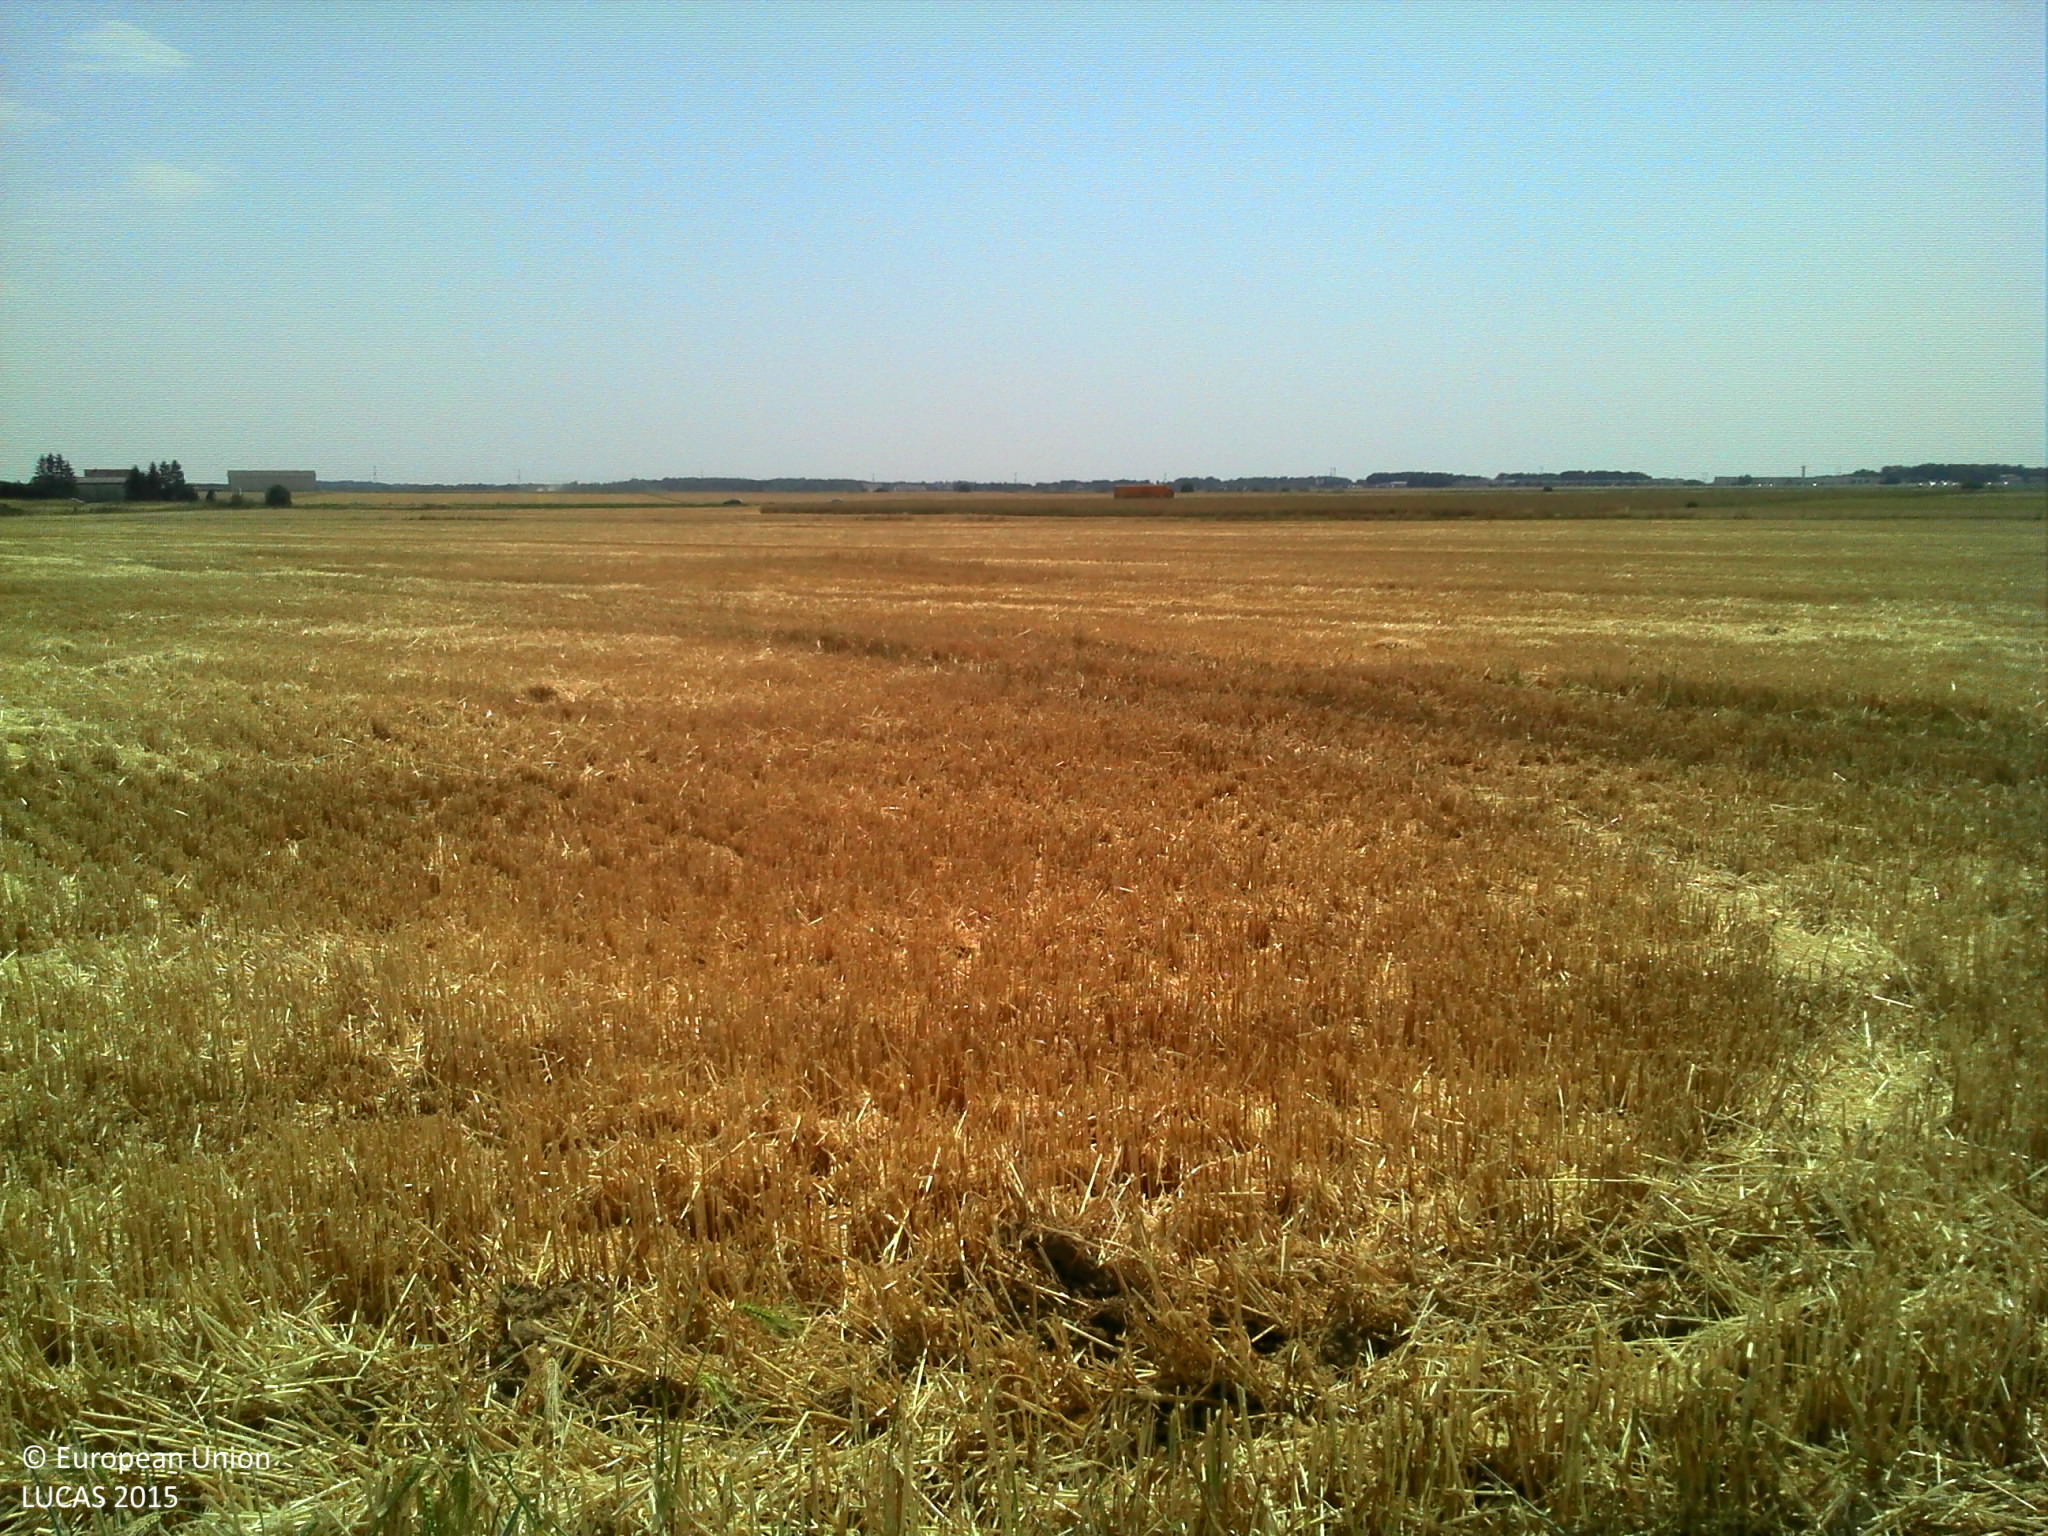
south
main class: Cropland
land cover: Barley
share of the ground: > 75 %
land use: Agriculture (excluding fallow land and kitchen gardens)
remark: Harvested field
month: July
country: FR
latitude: 48.9076
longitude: 1.2624
